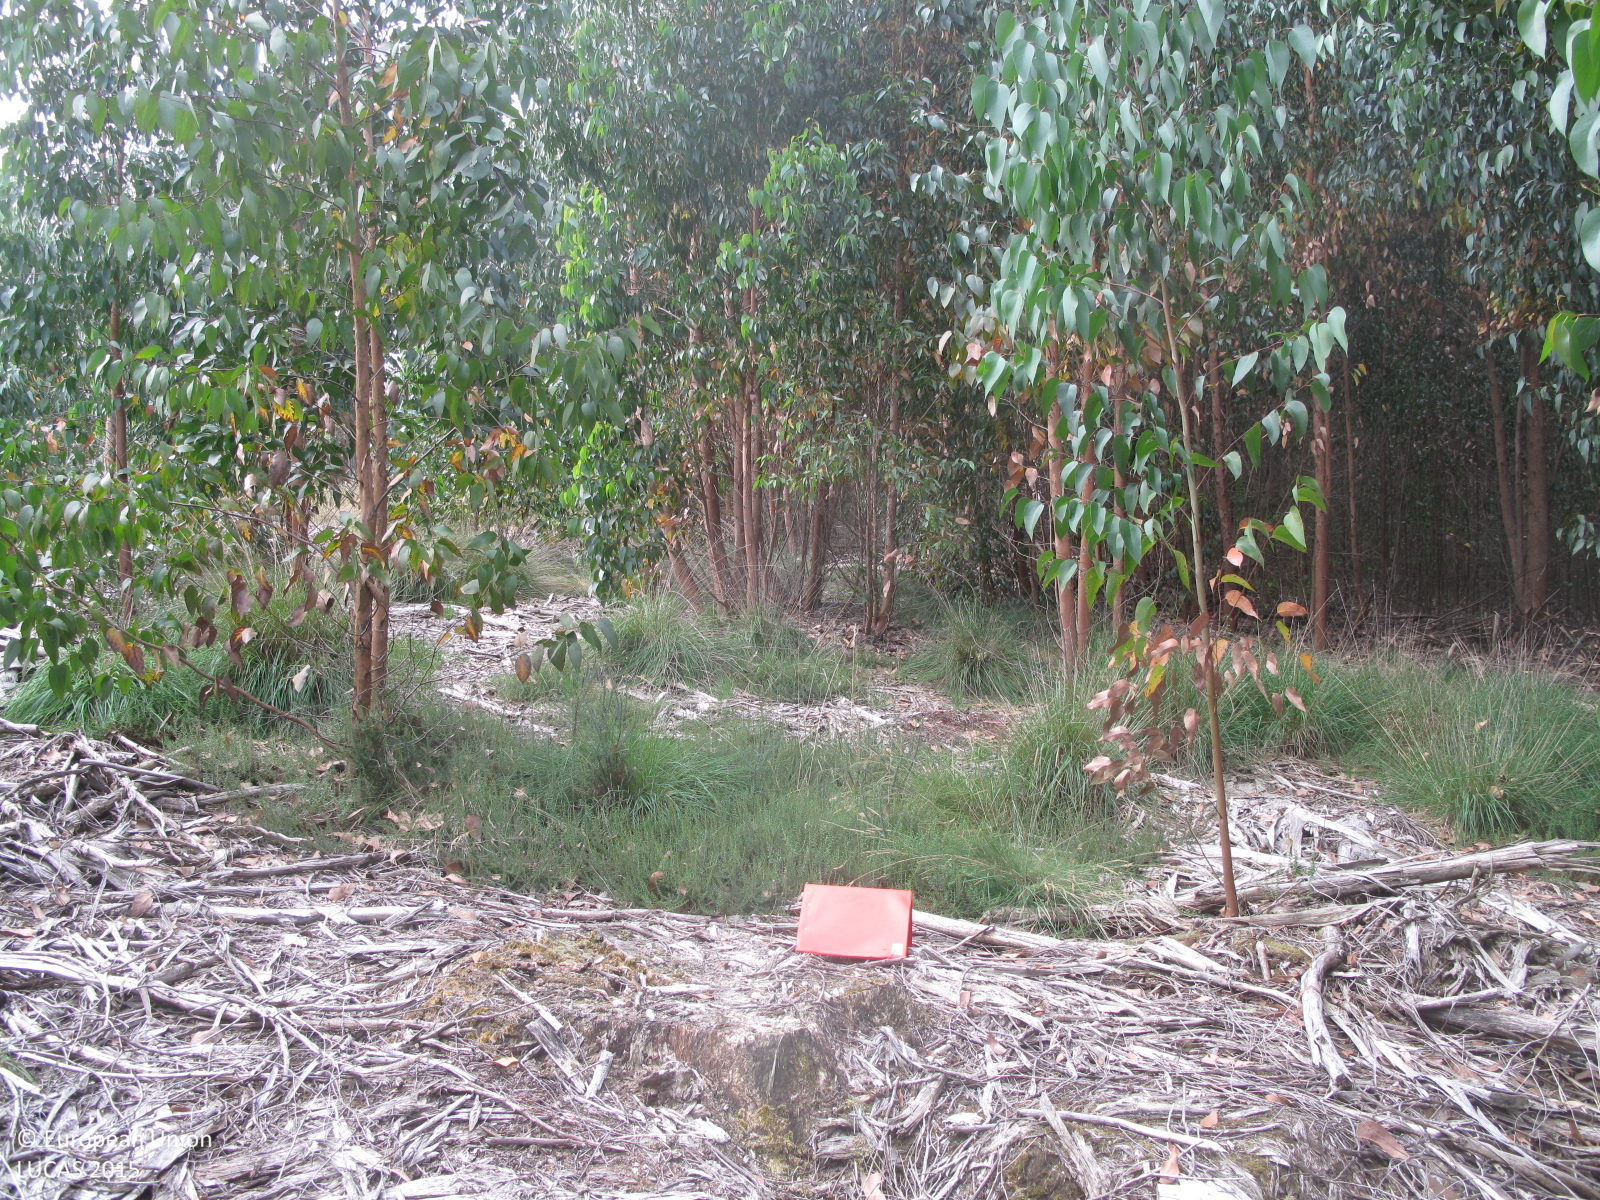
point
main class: Woodland
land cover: Broadleaved woodland
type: exotic forest
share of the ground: 50 - 75 %
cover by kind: broadleaved forest trees 60 %, unconsolidated bare surface 20 %, shrubs 10 %, herbaceous plants 10 %
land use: Forestry
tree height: > 5 m
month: July
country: ES
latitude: 43.2951
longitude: -8.1048
